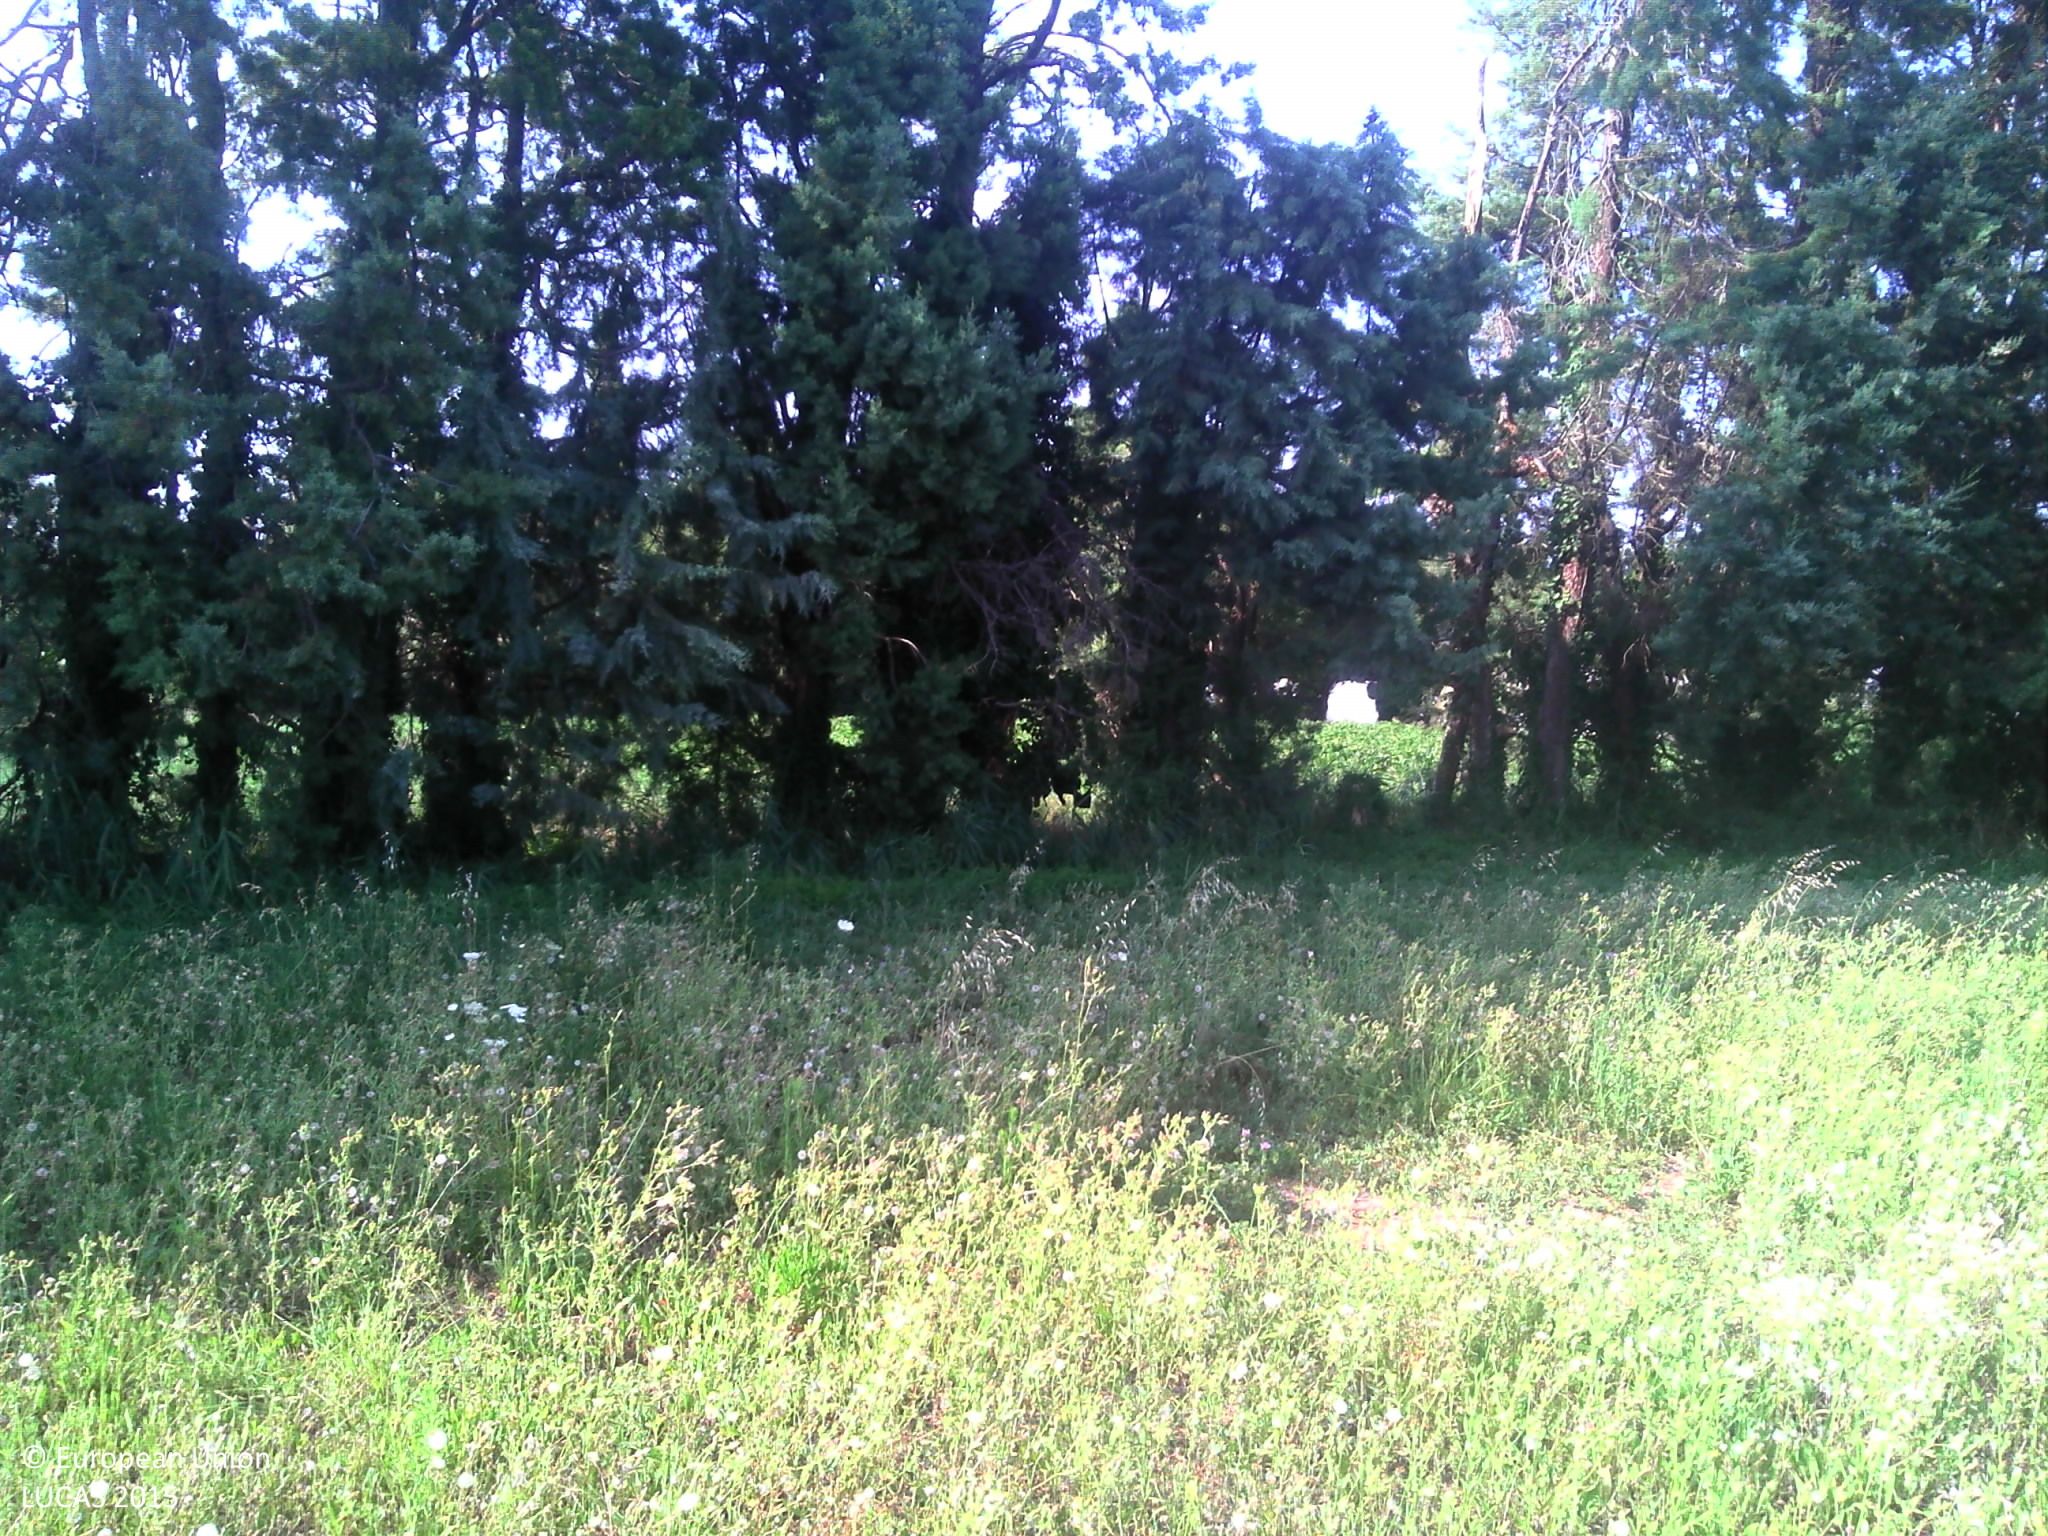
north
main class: Cropland
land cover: Olive groves
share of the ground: 50 - 75 %
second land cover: Grassland without tree/shrub cover
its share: 50 - 75 %
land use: Agriculture (excluding fallow land and kitchen gardens)
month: July
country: FR
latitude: 43.9113
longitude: 4.7662
